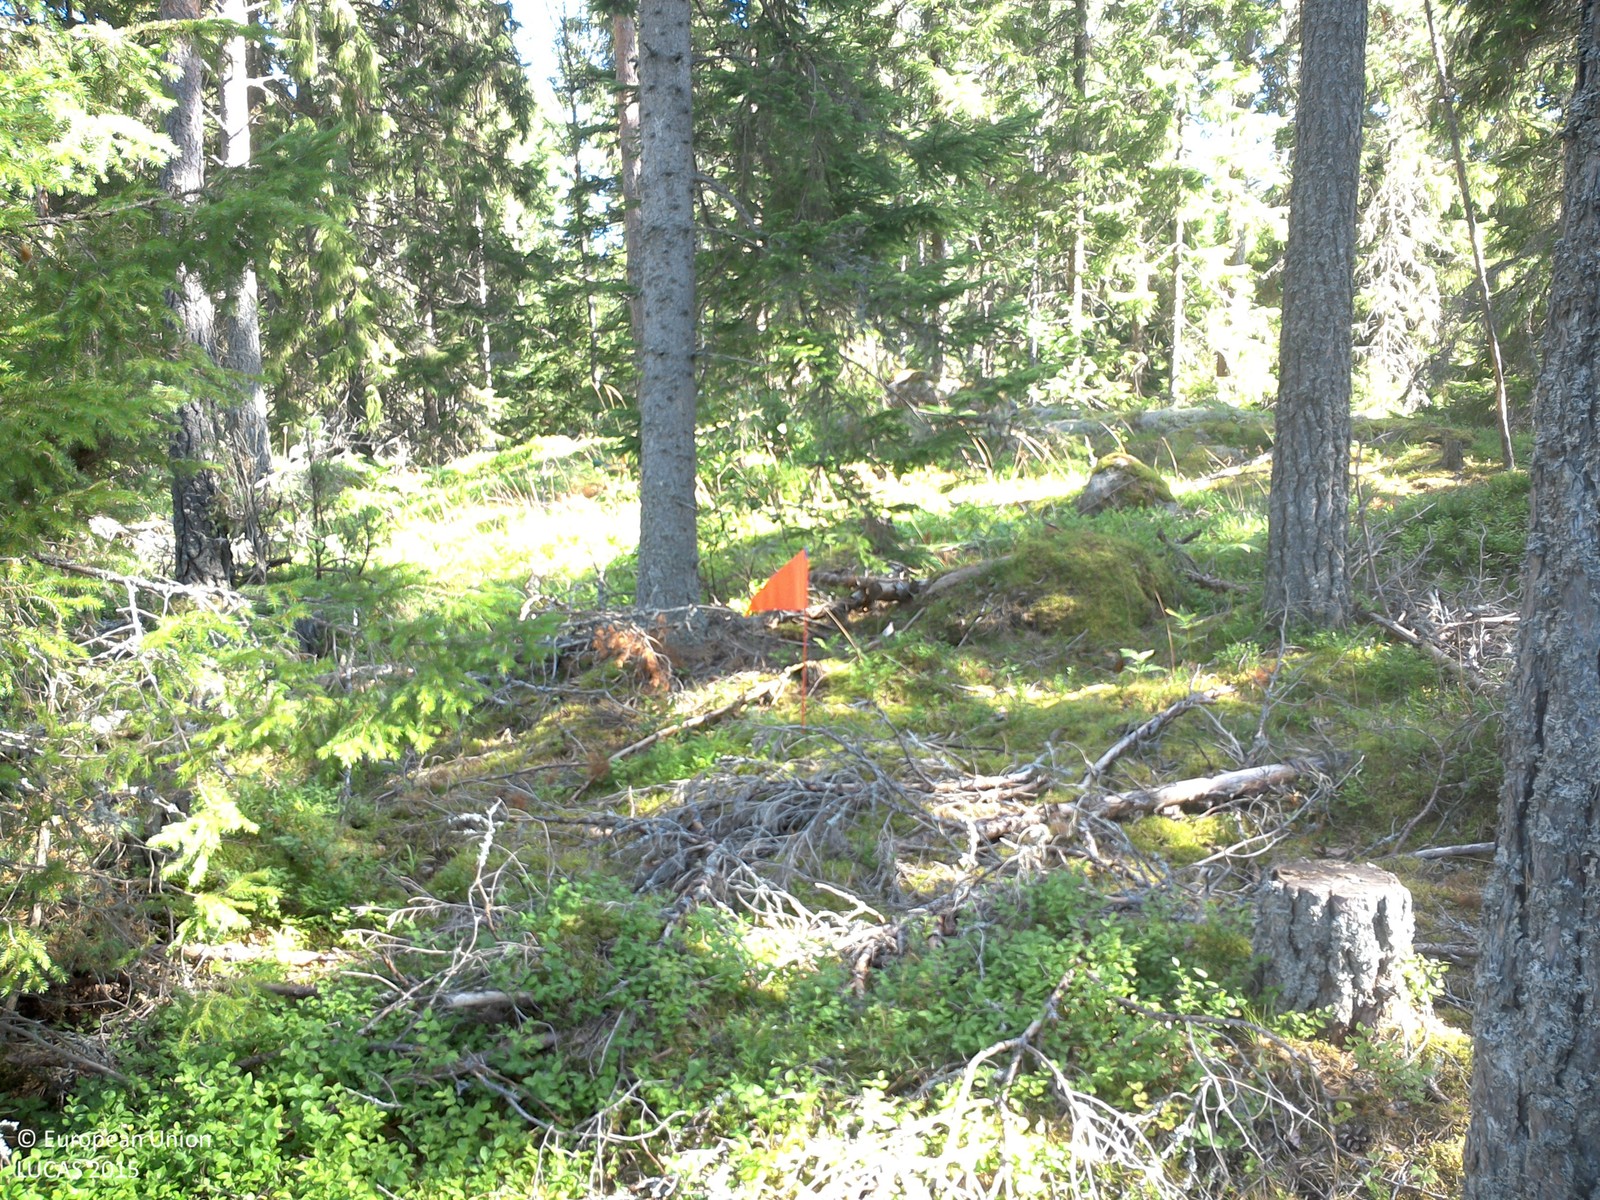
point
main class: Woodland
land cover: Pine dominated coniferous woodland
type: boreal forest
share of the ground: 25 - 50 %
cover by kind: coniferous forest trees 40 %, lichens and mosses 40 %, herbaceous plants 20 %
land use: Forestry
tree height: > 5 m
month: August
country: SE
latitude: 57.8804
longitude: 15.3074
